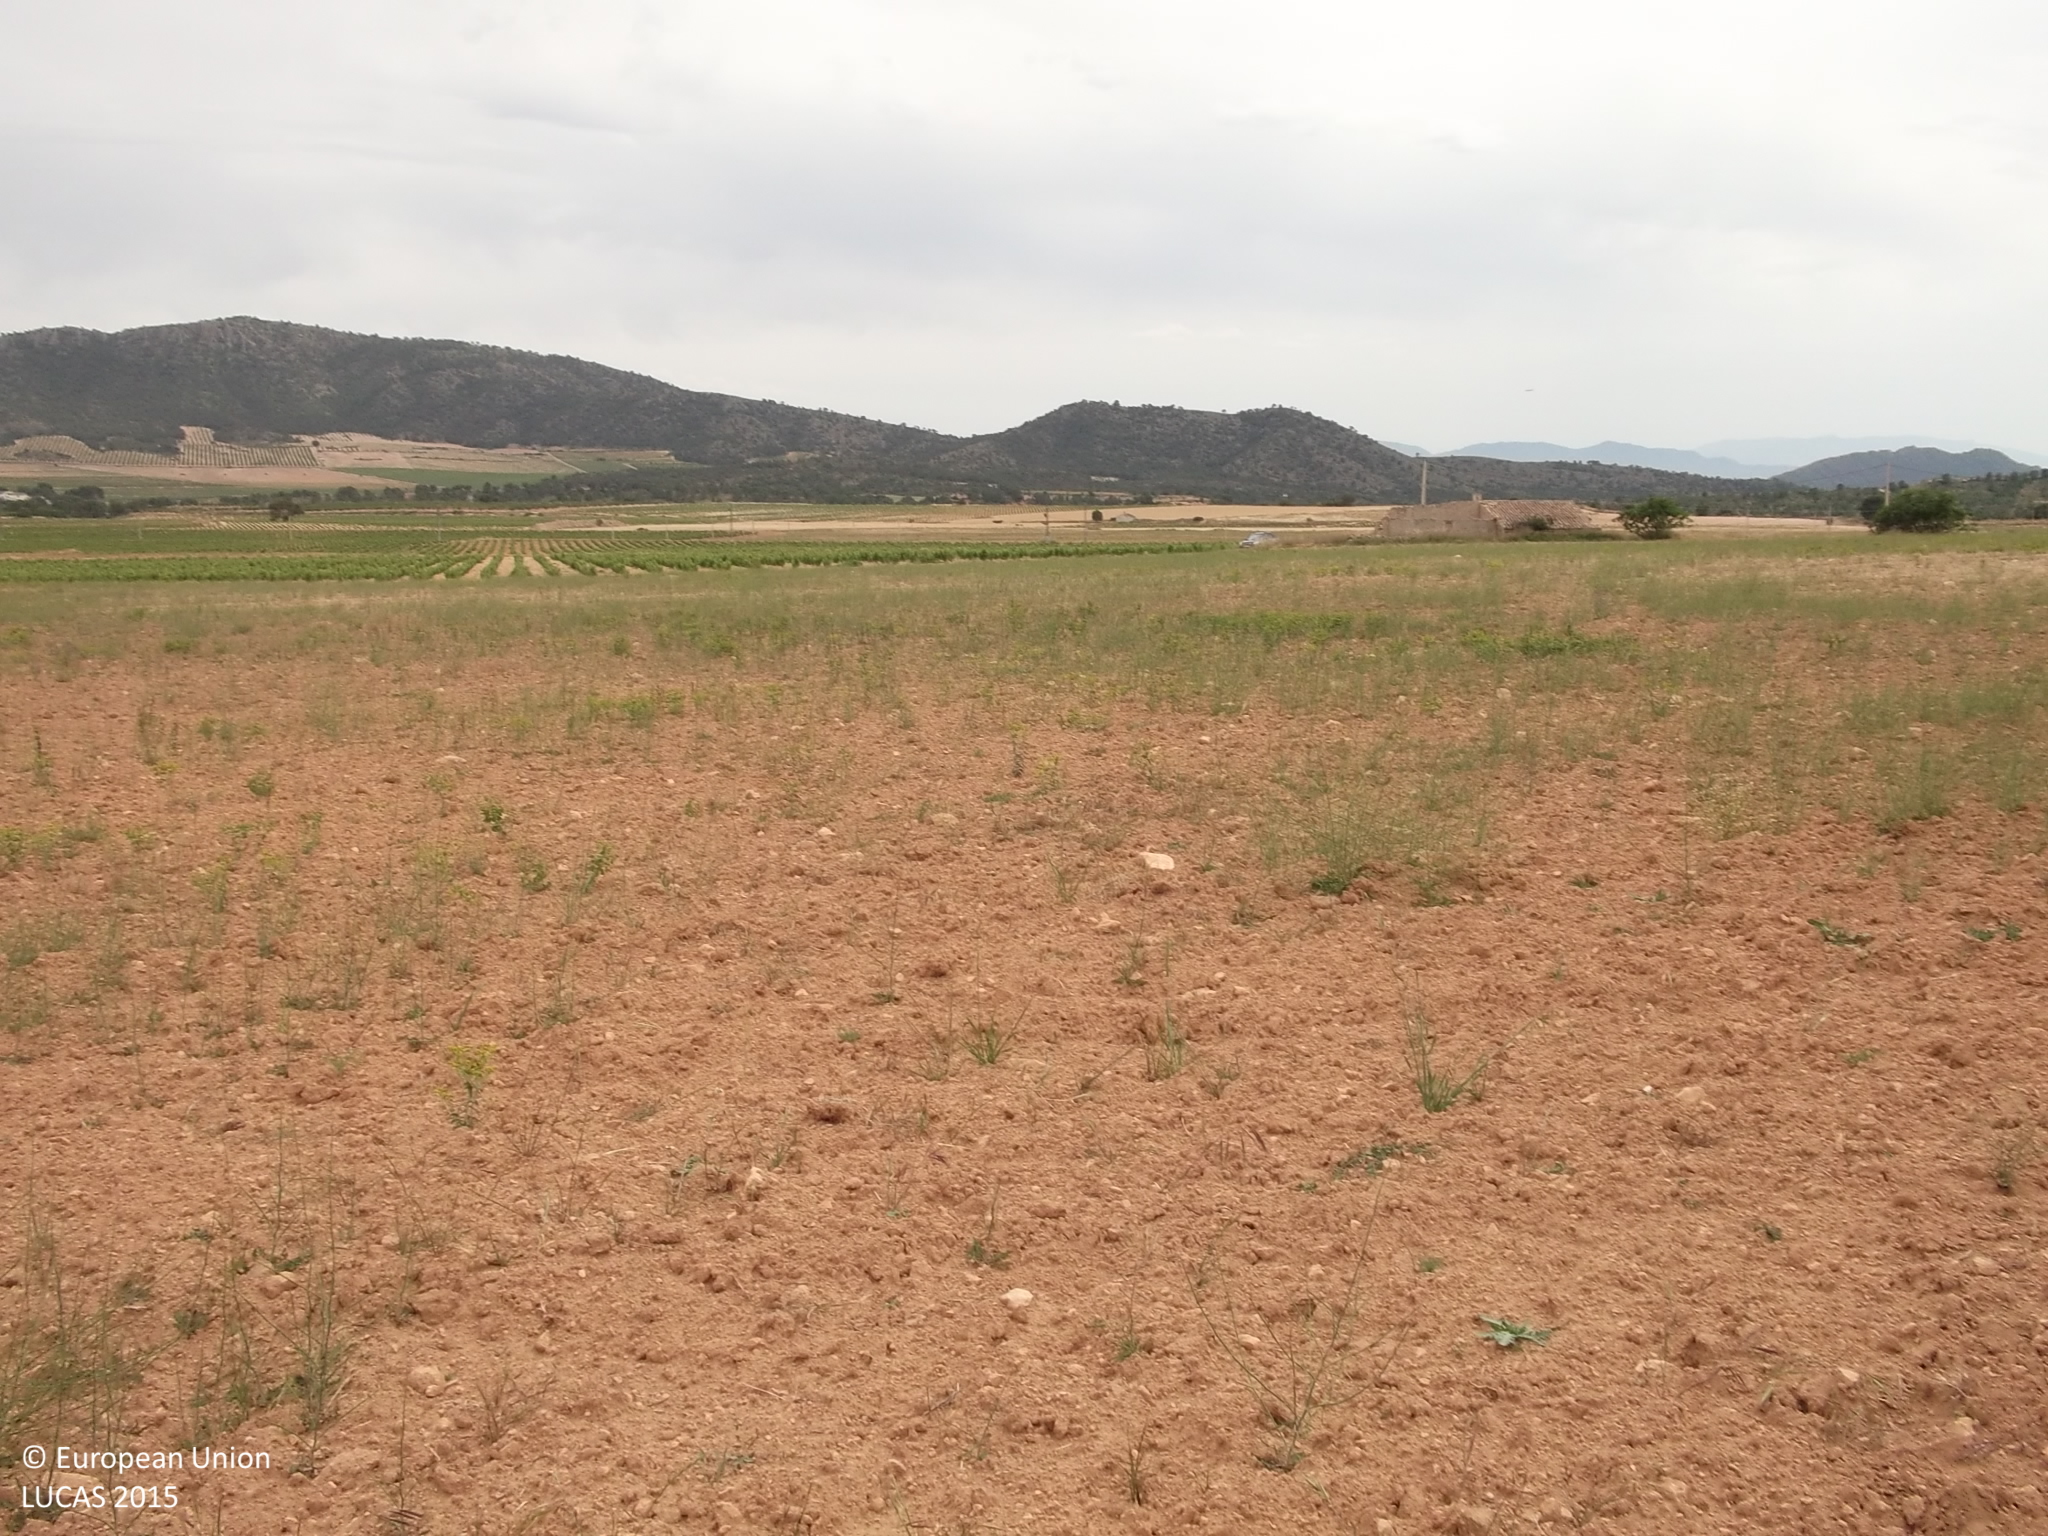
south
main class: Grassland
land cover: Spontaneously vegetated surfaces
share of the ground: 25 - 50 %
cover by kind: unconsolidated bare surface 70 %, herbaceous plants 30 %
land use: Fallow land
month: May
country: ES
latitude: 38.4811
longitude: -1.4434
